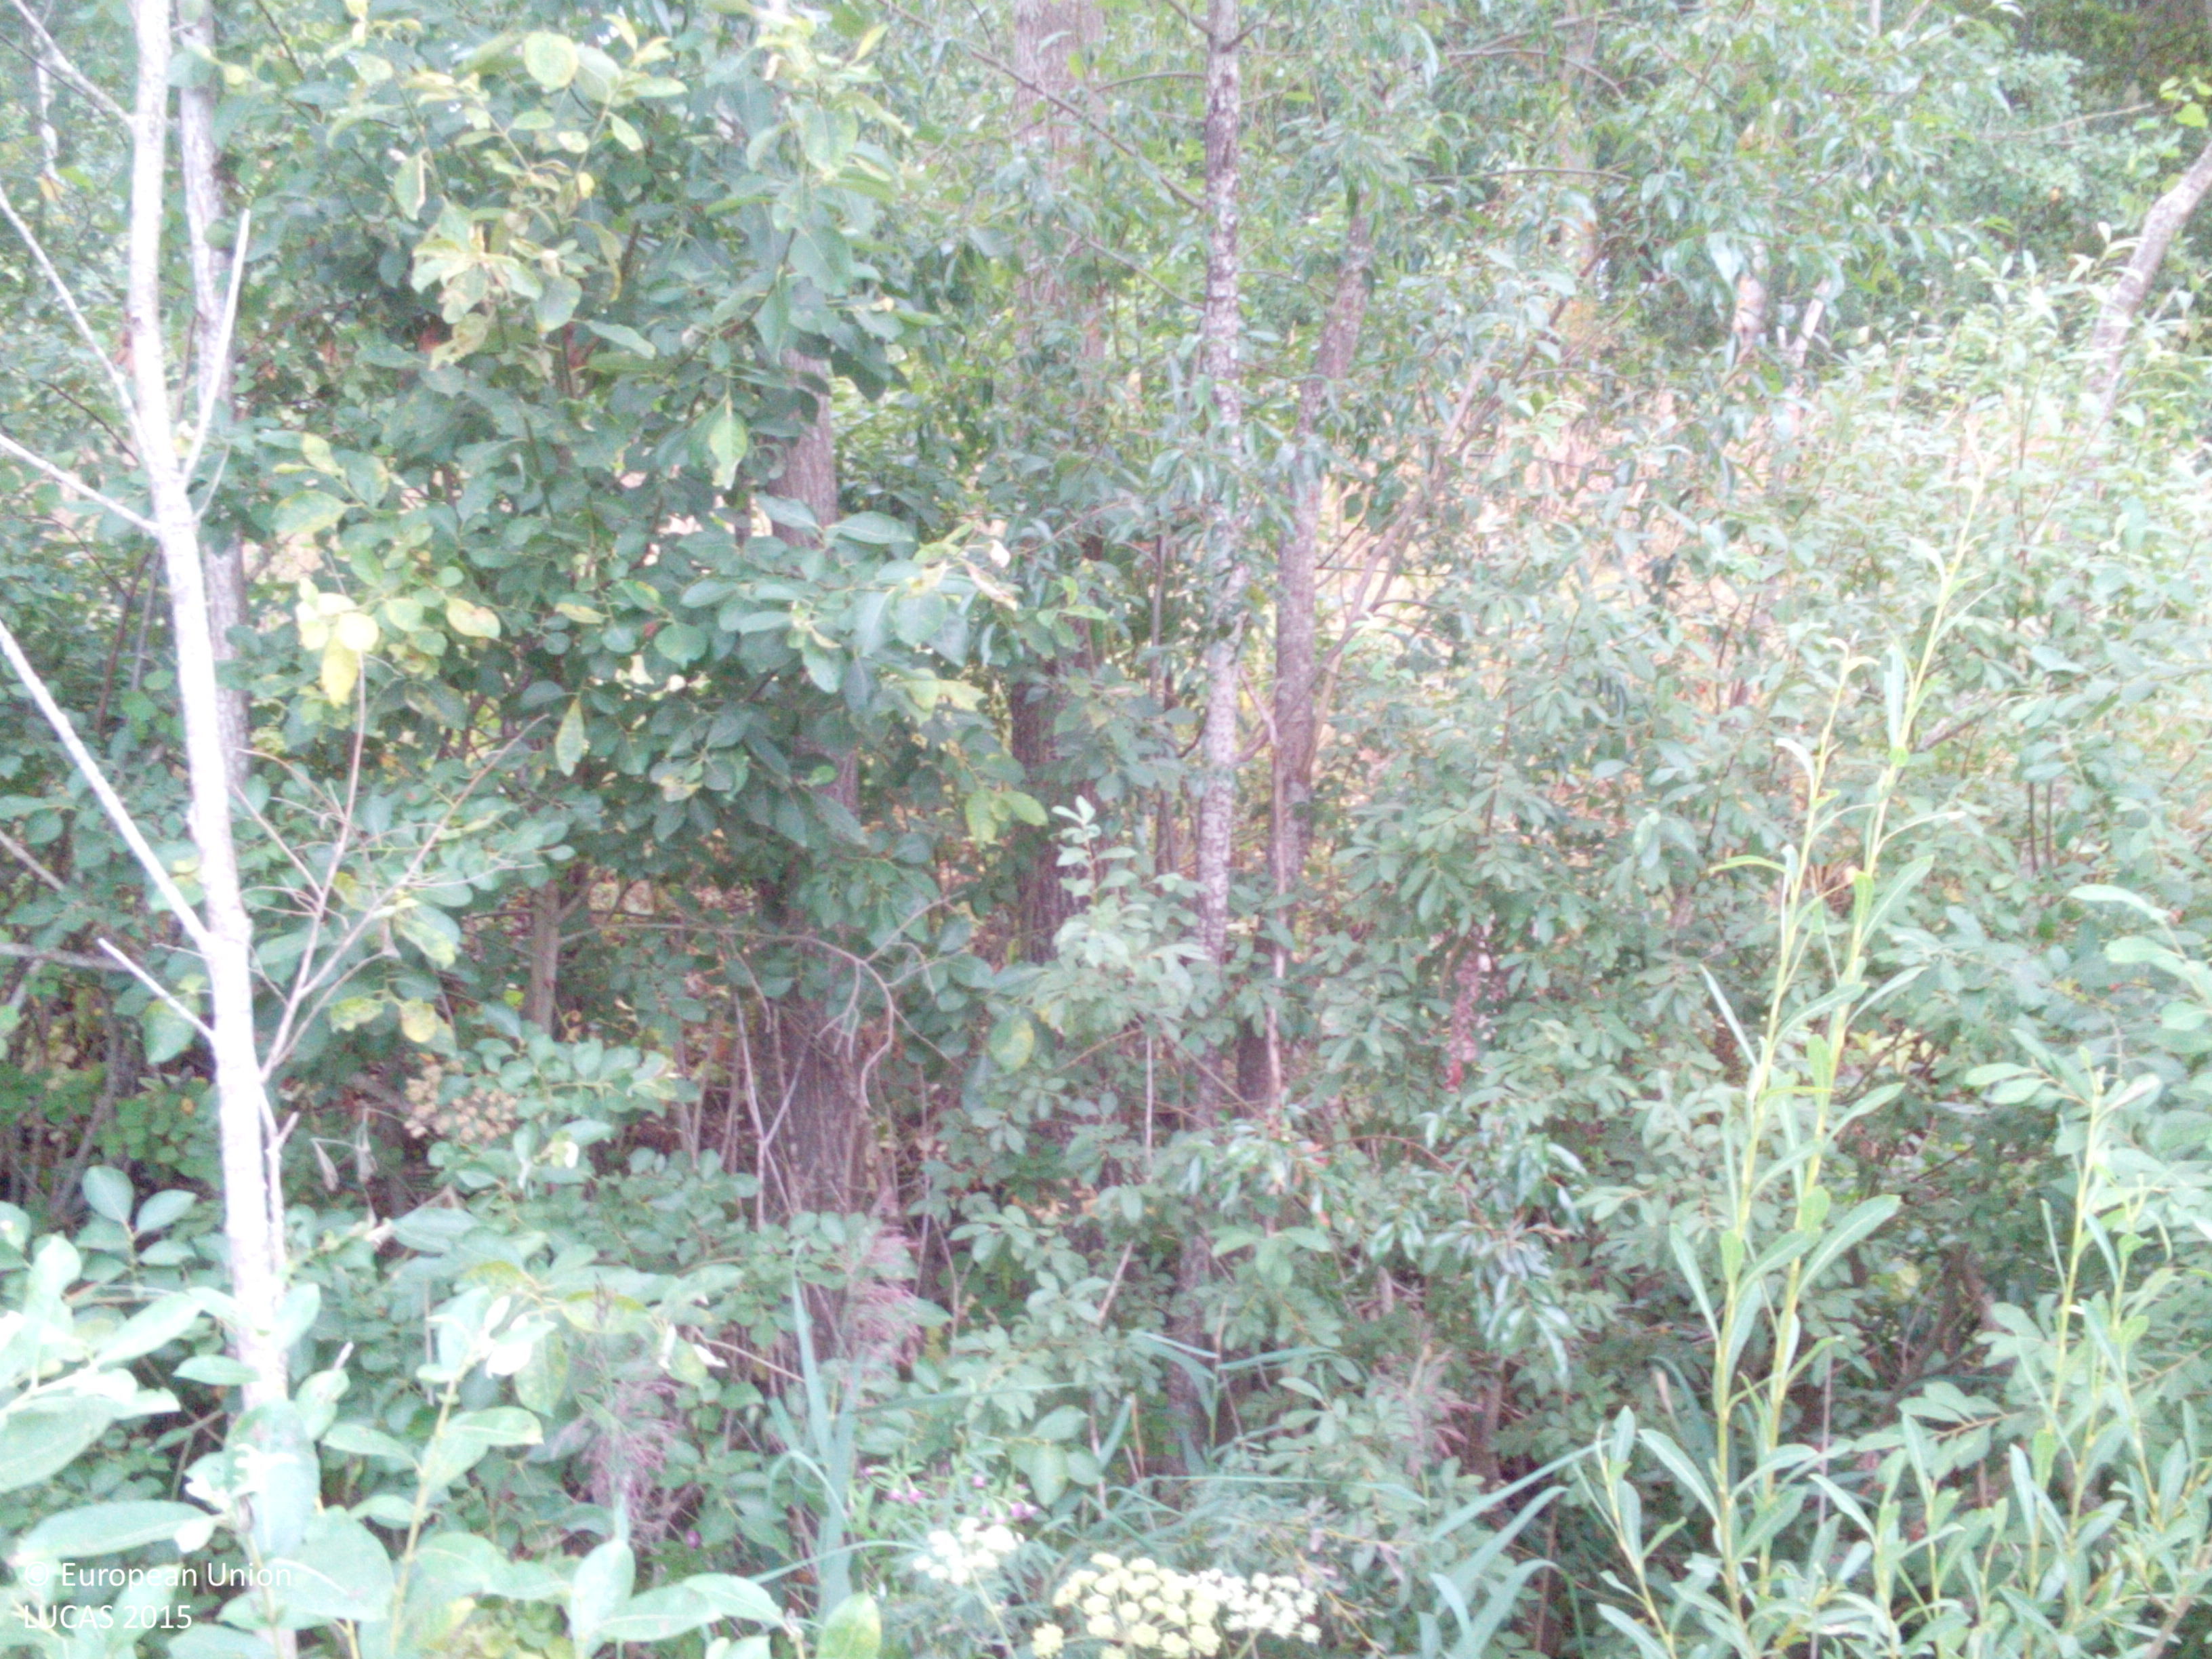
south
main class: Woodland
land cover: Broadleaved woodland
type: non-riverine alder, birch or aspen forest
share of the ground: 25 - 50 %
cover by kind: herbaceous plants 60 %, broadleaved forest trees 40 %
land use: Forestry
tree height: > 5 m
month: August
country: LV
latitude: 56.2064
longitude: 21.1786
